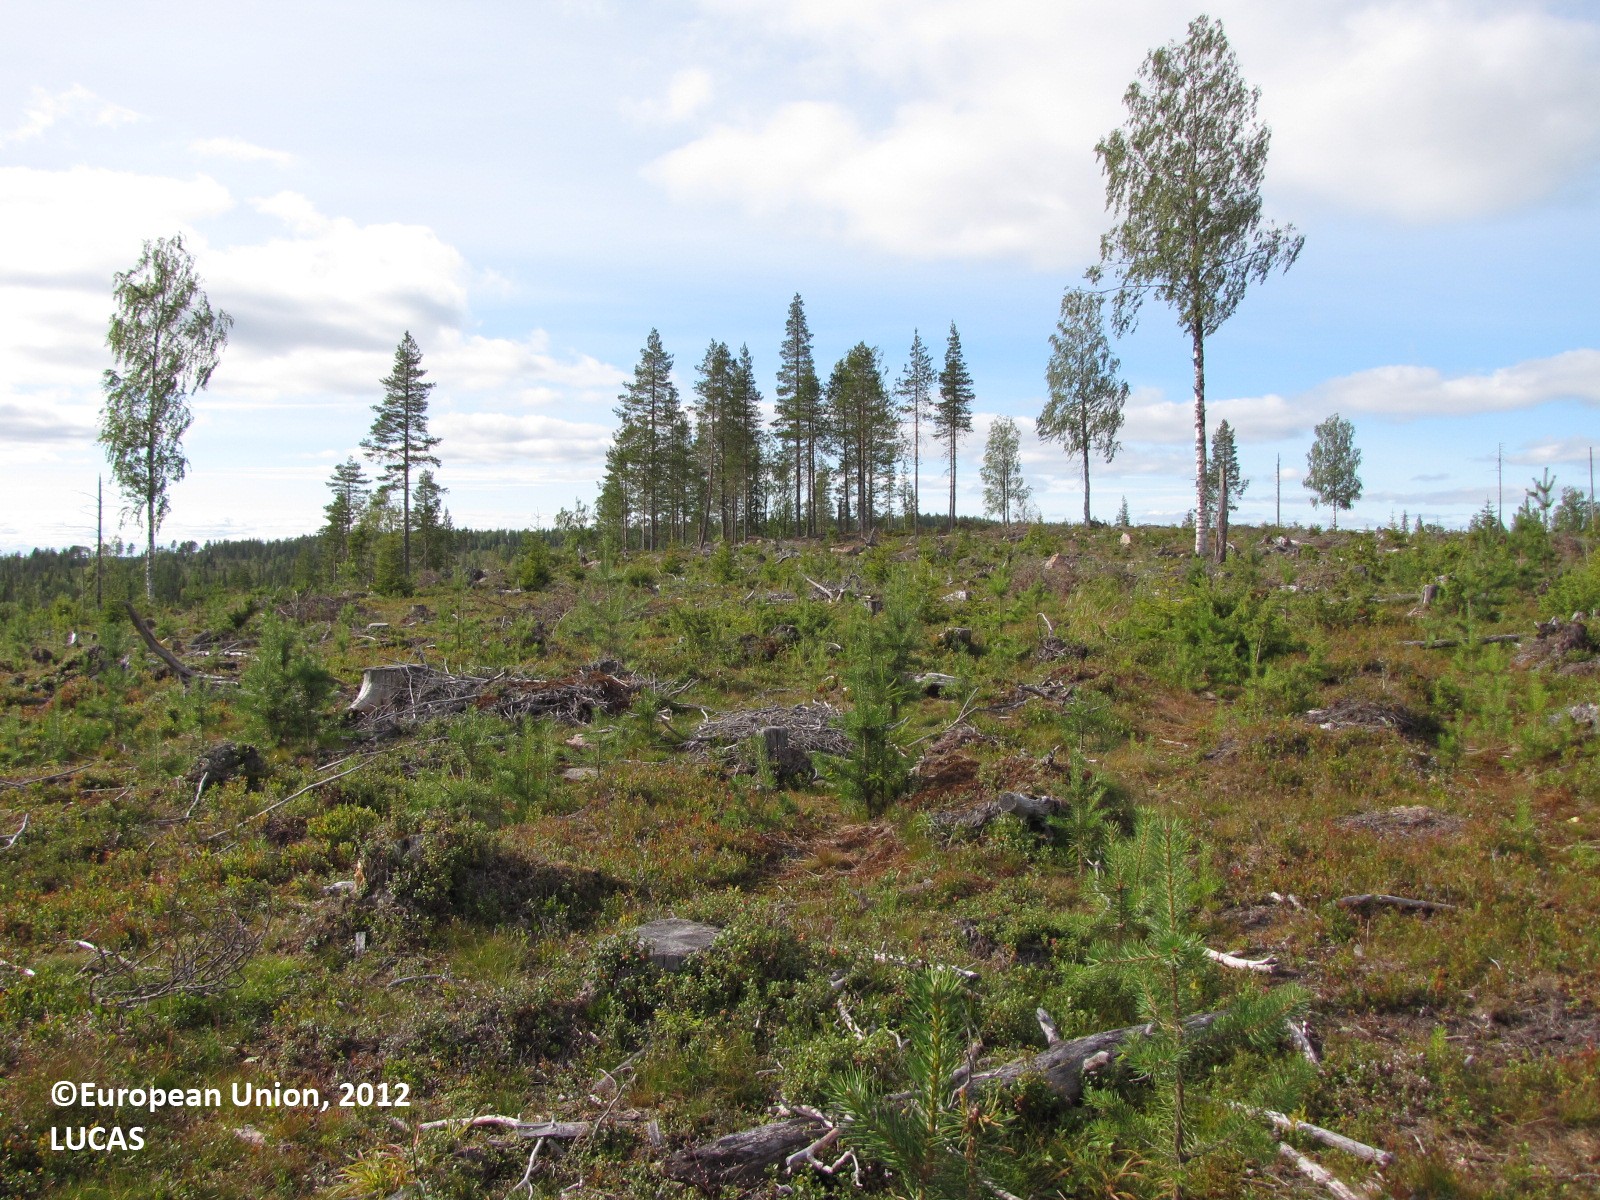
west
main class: Woodland
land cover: Pine dominated mixed woodland
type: boreal forest
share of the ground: 10 - 25 %
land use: Forestry
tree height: < 5 m
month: August
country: FI
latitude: 66.9266
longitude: 24.6526
